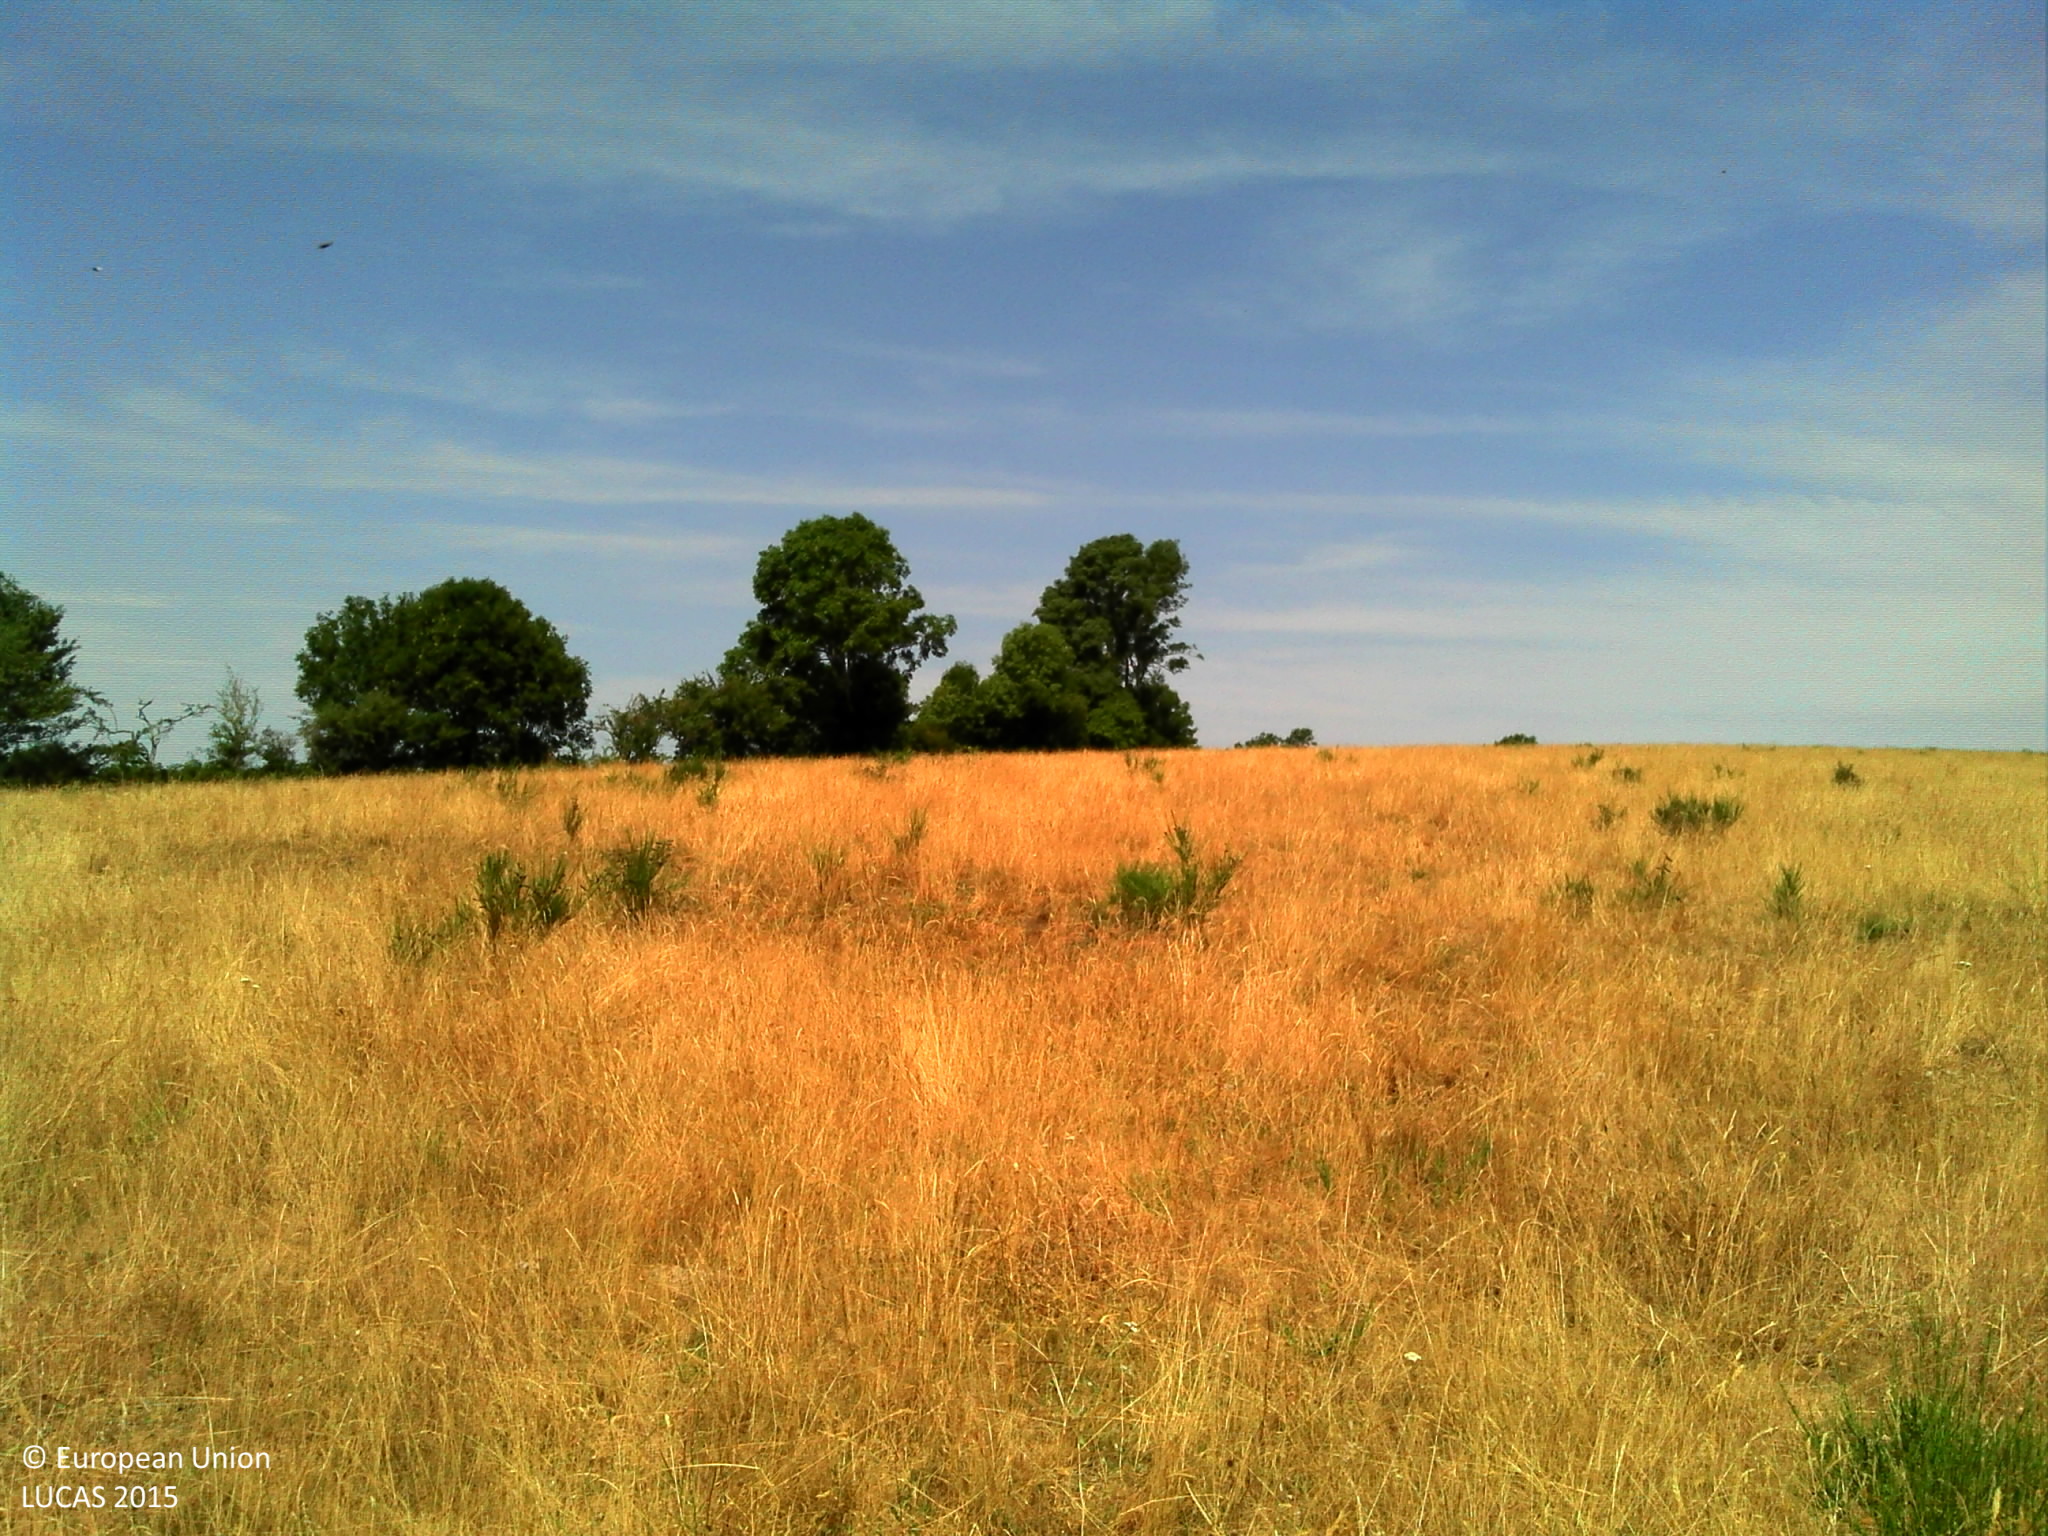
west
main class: Grassland
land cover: Grassland without tree/shrub cover
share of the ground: > 75 %
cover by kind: herbaceous plants 100 %
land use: Agriculture (excluding fallow land and kitchen gardens)
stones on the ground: 10 - 25 %
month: July
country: FR
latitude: 44.5462
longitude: 2.9677
